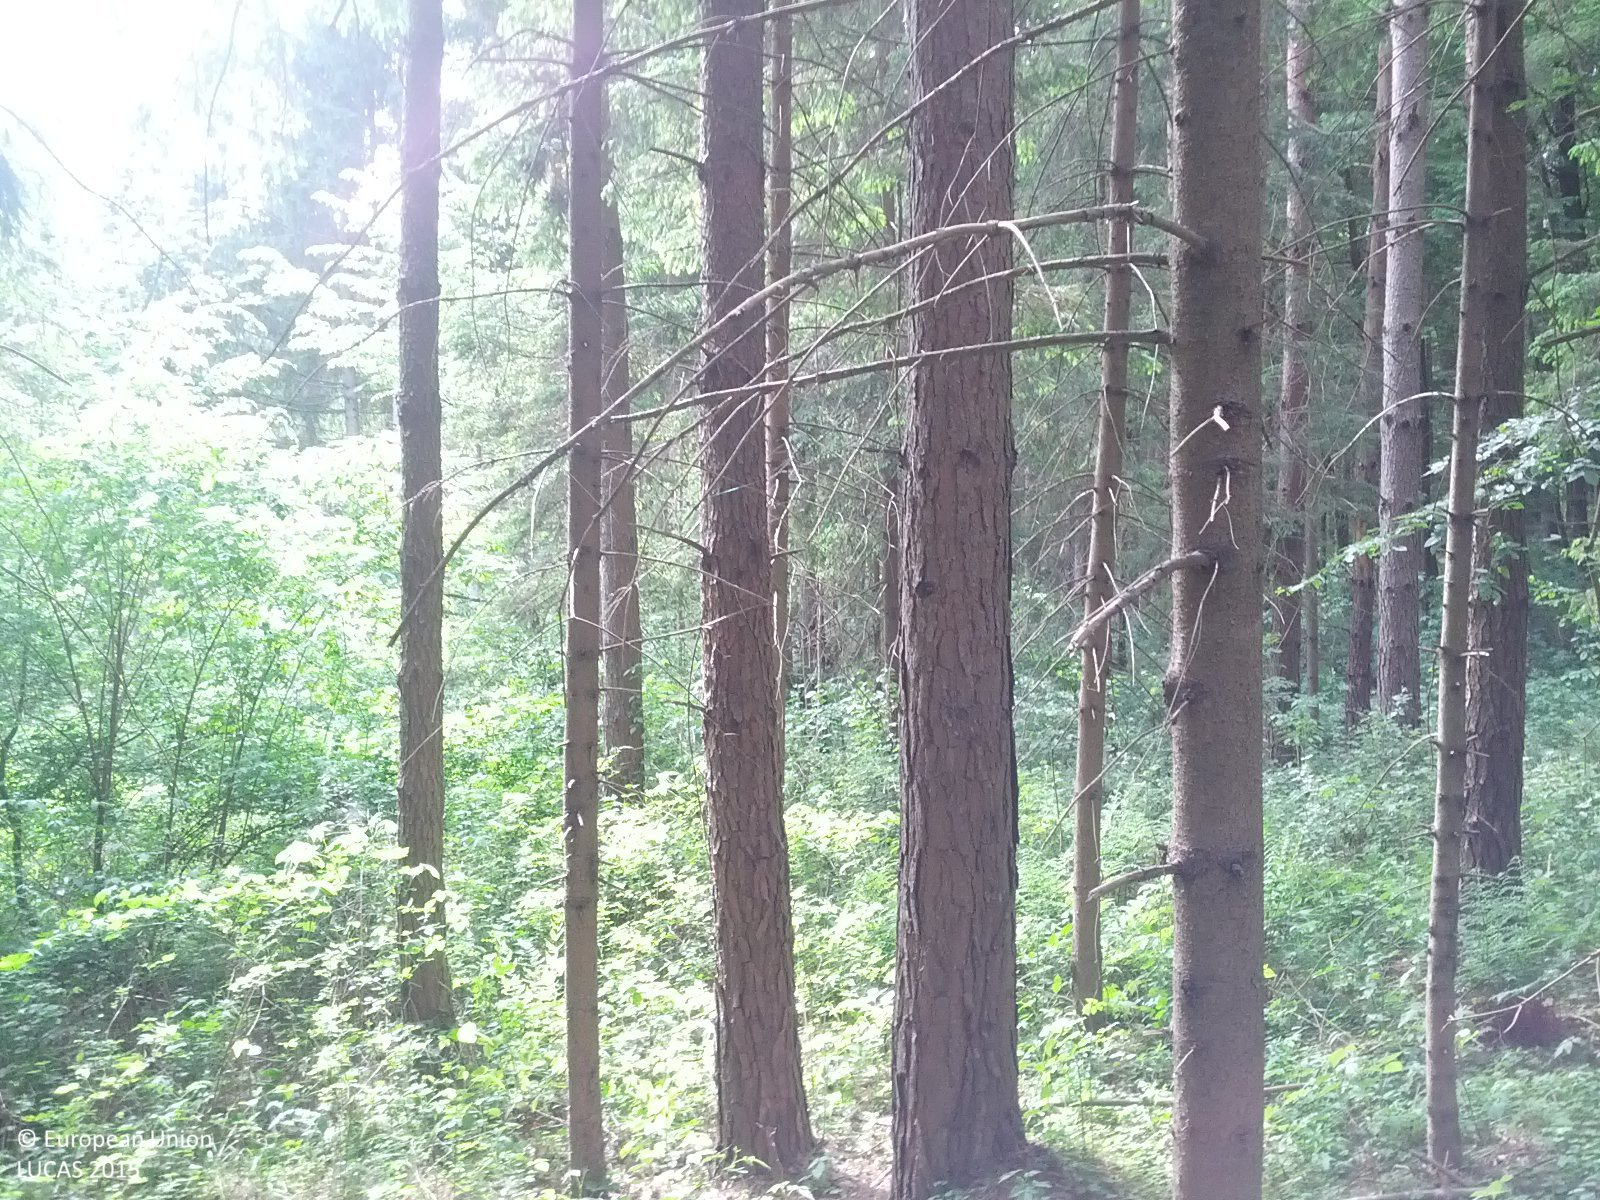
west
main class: Woodland
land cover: Pine dominated coniferous woodland
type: hemiboreal forest and nemoral coniferous forest and mixed broadleaved-coniferous forest
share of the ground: > 75 %
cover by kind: coniferous forest trees 70 %, broadleaved forest trees 10 %, herbaceous plants 10 %, shrubs 5 %, lichens and mosses 5 %
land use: Forestry
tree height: > 5 m
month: May
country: AT
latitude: 47.3505
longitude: 16.1048
